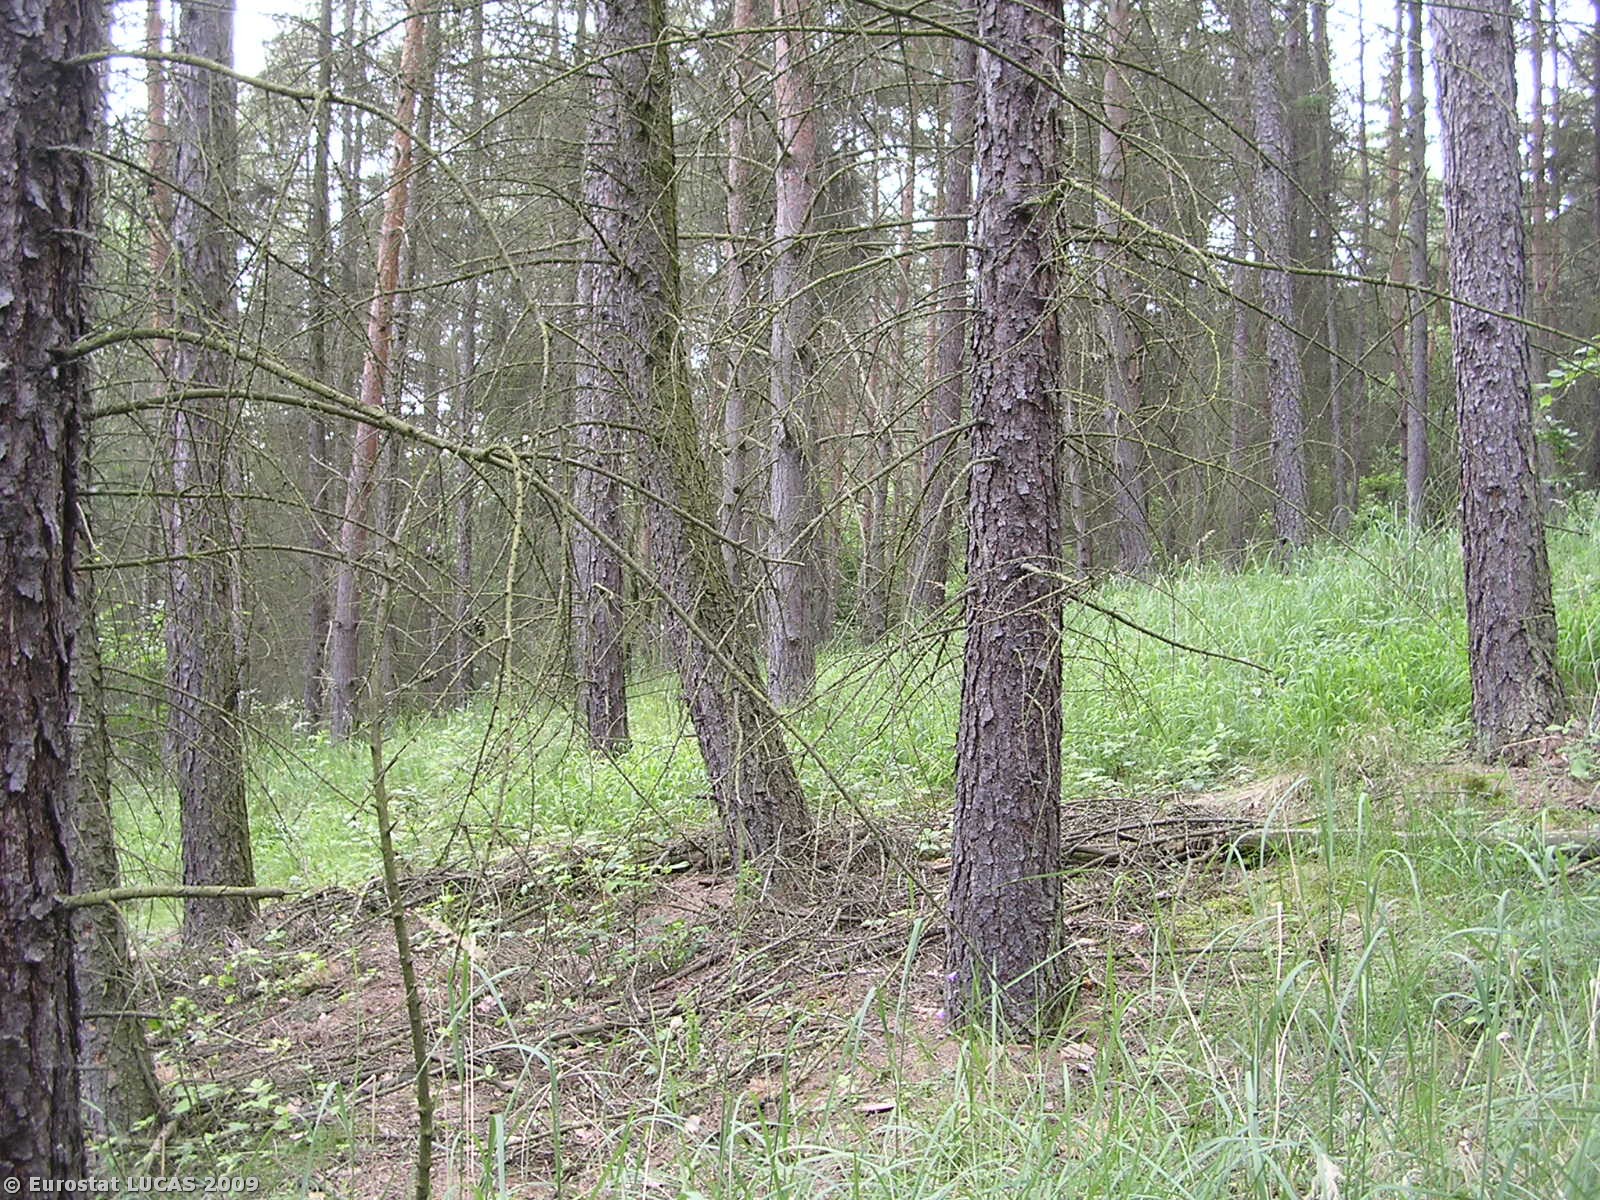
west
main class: Woodland
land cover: Coniferous woodland
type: hemiboreal forest and nemoral coniferous forest and mixed broadleaved-coniferous forest
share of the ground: > 75 %
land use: Forestry
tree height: > 5 m
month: June
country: CZ
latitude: 50.4727
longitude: 14.5248
